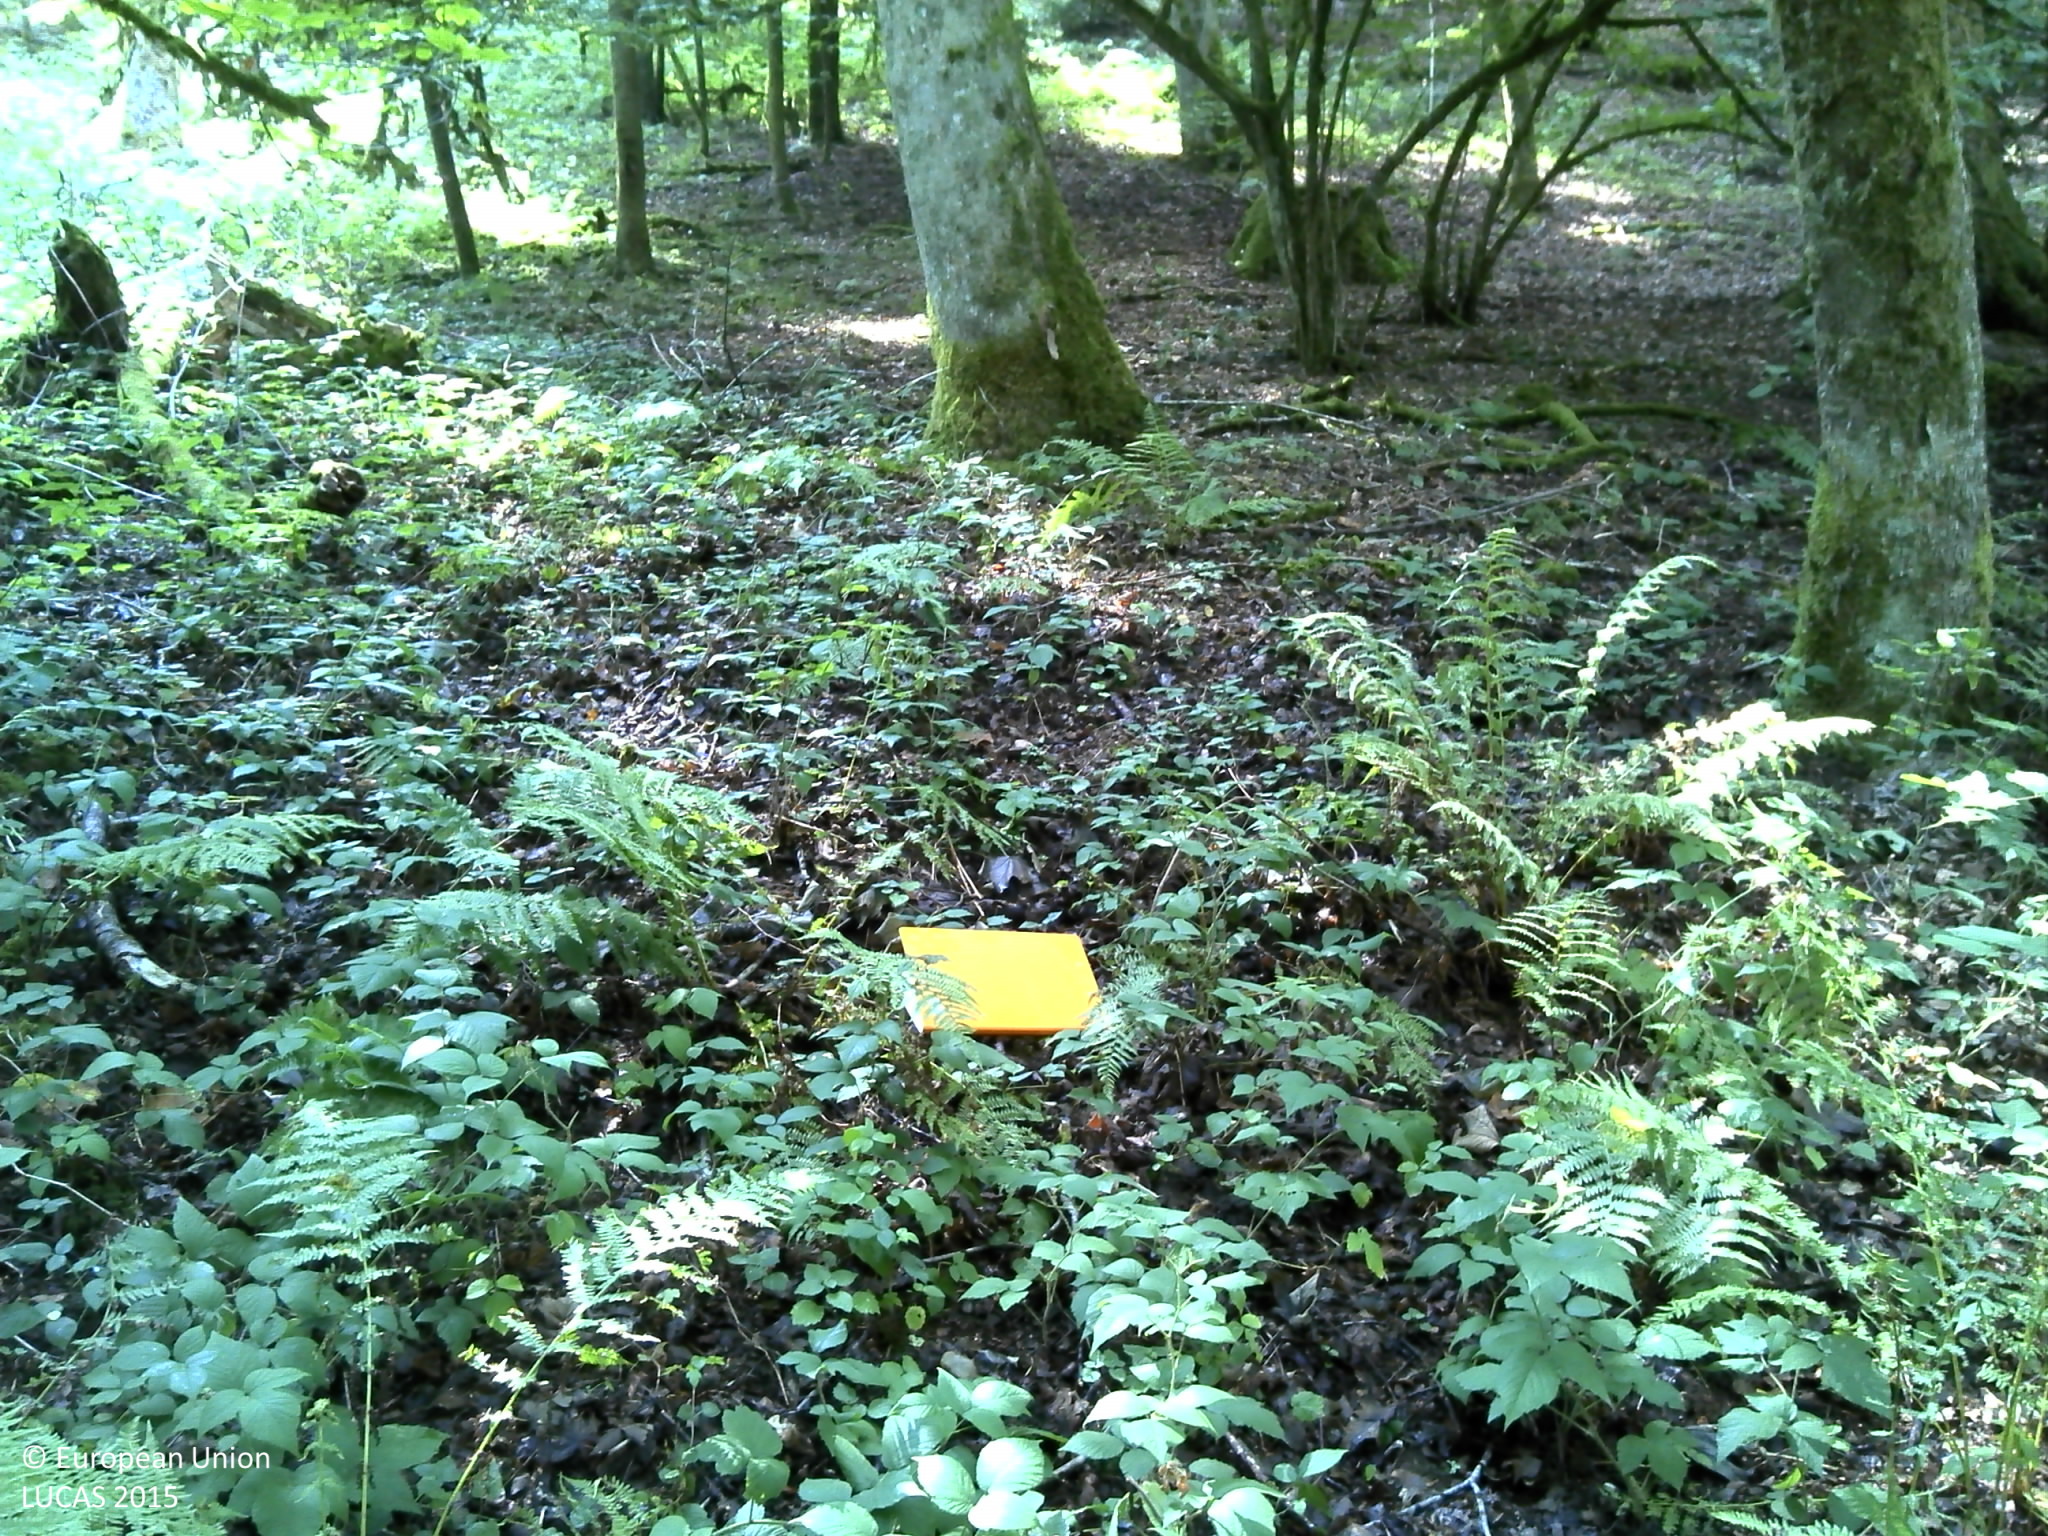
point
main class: Woodland
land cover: Spruce dominated mixed woodland
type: mountainous beech forest
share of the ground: > 75 %
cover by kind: broadleaved forest trees 50 %, coniferous forest trees 45 %, herbaceous plants 5 %
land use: Forestry
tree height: > 5 m
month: August
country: FR
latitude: 47.9546
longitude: 6.5864
